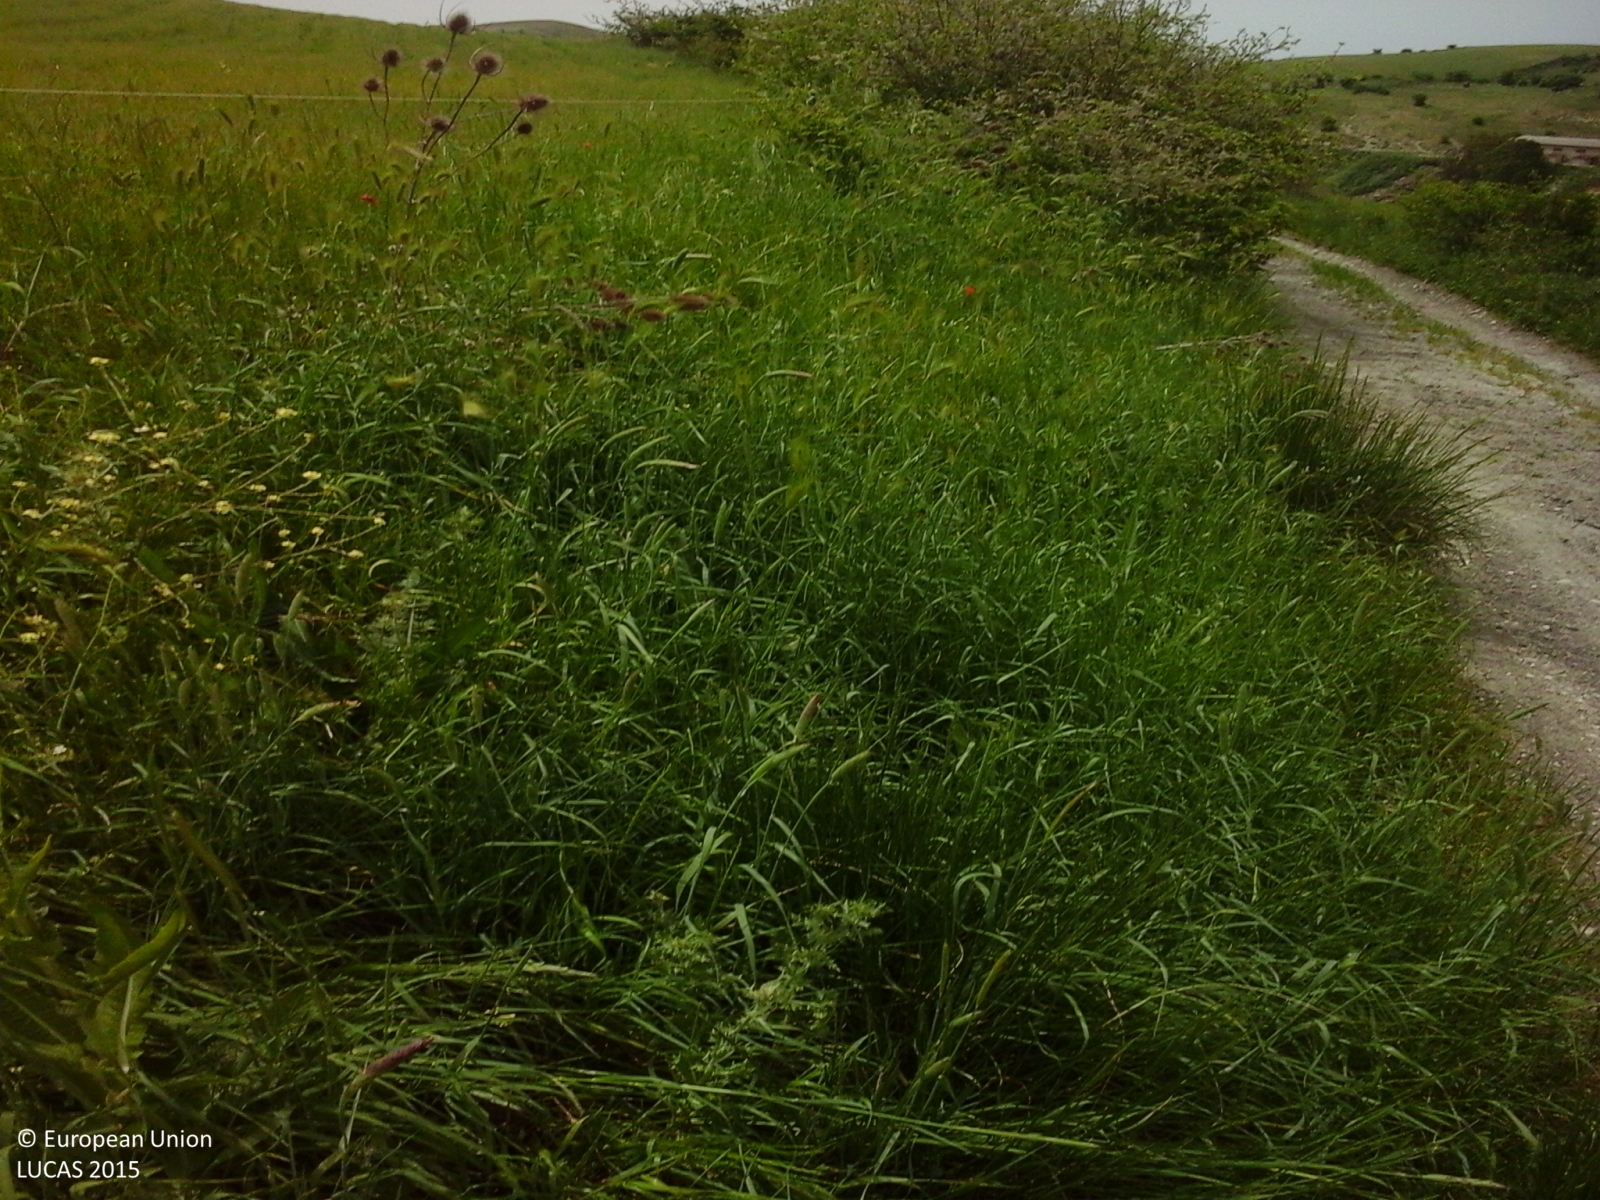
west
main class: Cropland
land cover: Durum wheat
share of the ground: > 75 %
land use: Agriculture (excluding fallow land and kitchen gardens)
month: May
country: IT
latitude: 37.7013
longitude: 13.5015
